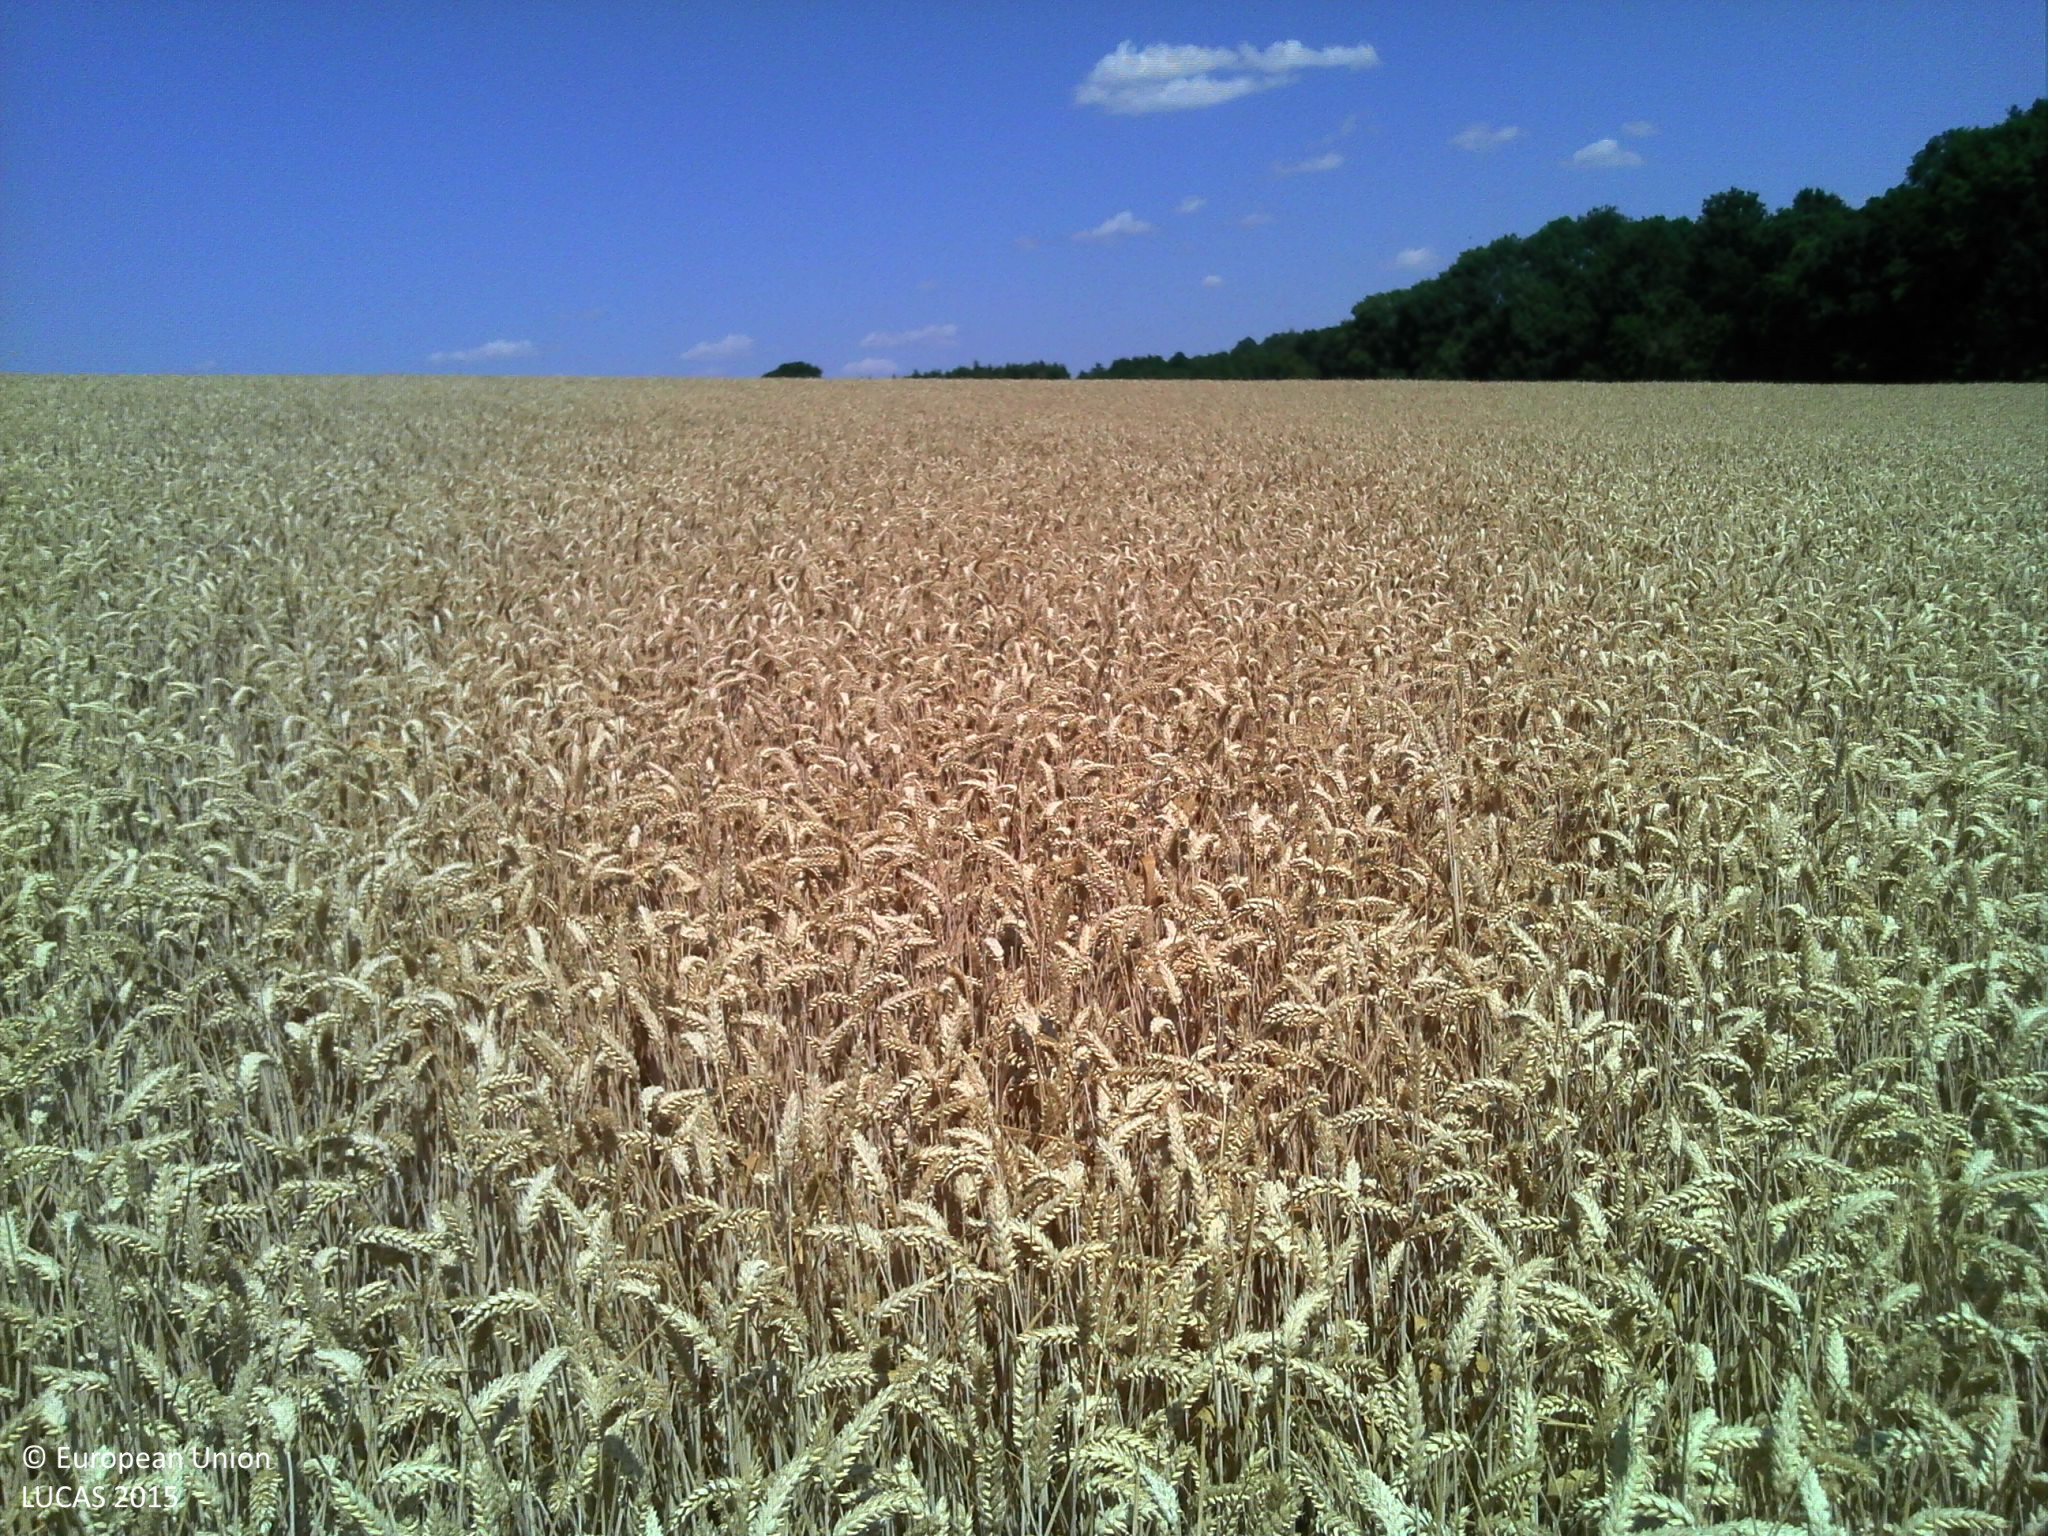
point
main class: Cropland
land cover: Common wheat
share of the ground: > 75 %
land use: Agriculture (excluding fallow land and kitchen gardens)
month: July
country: FR
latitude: 49.0166
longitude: 5.1167
